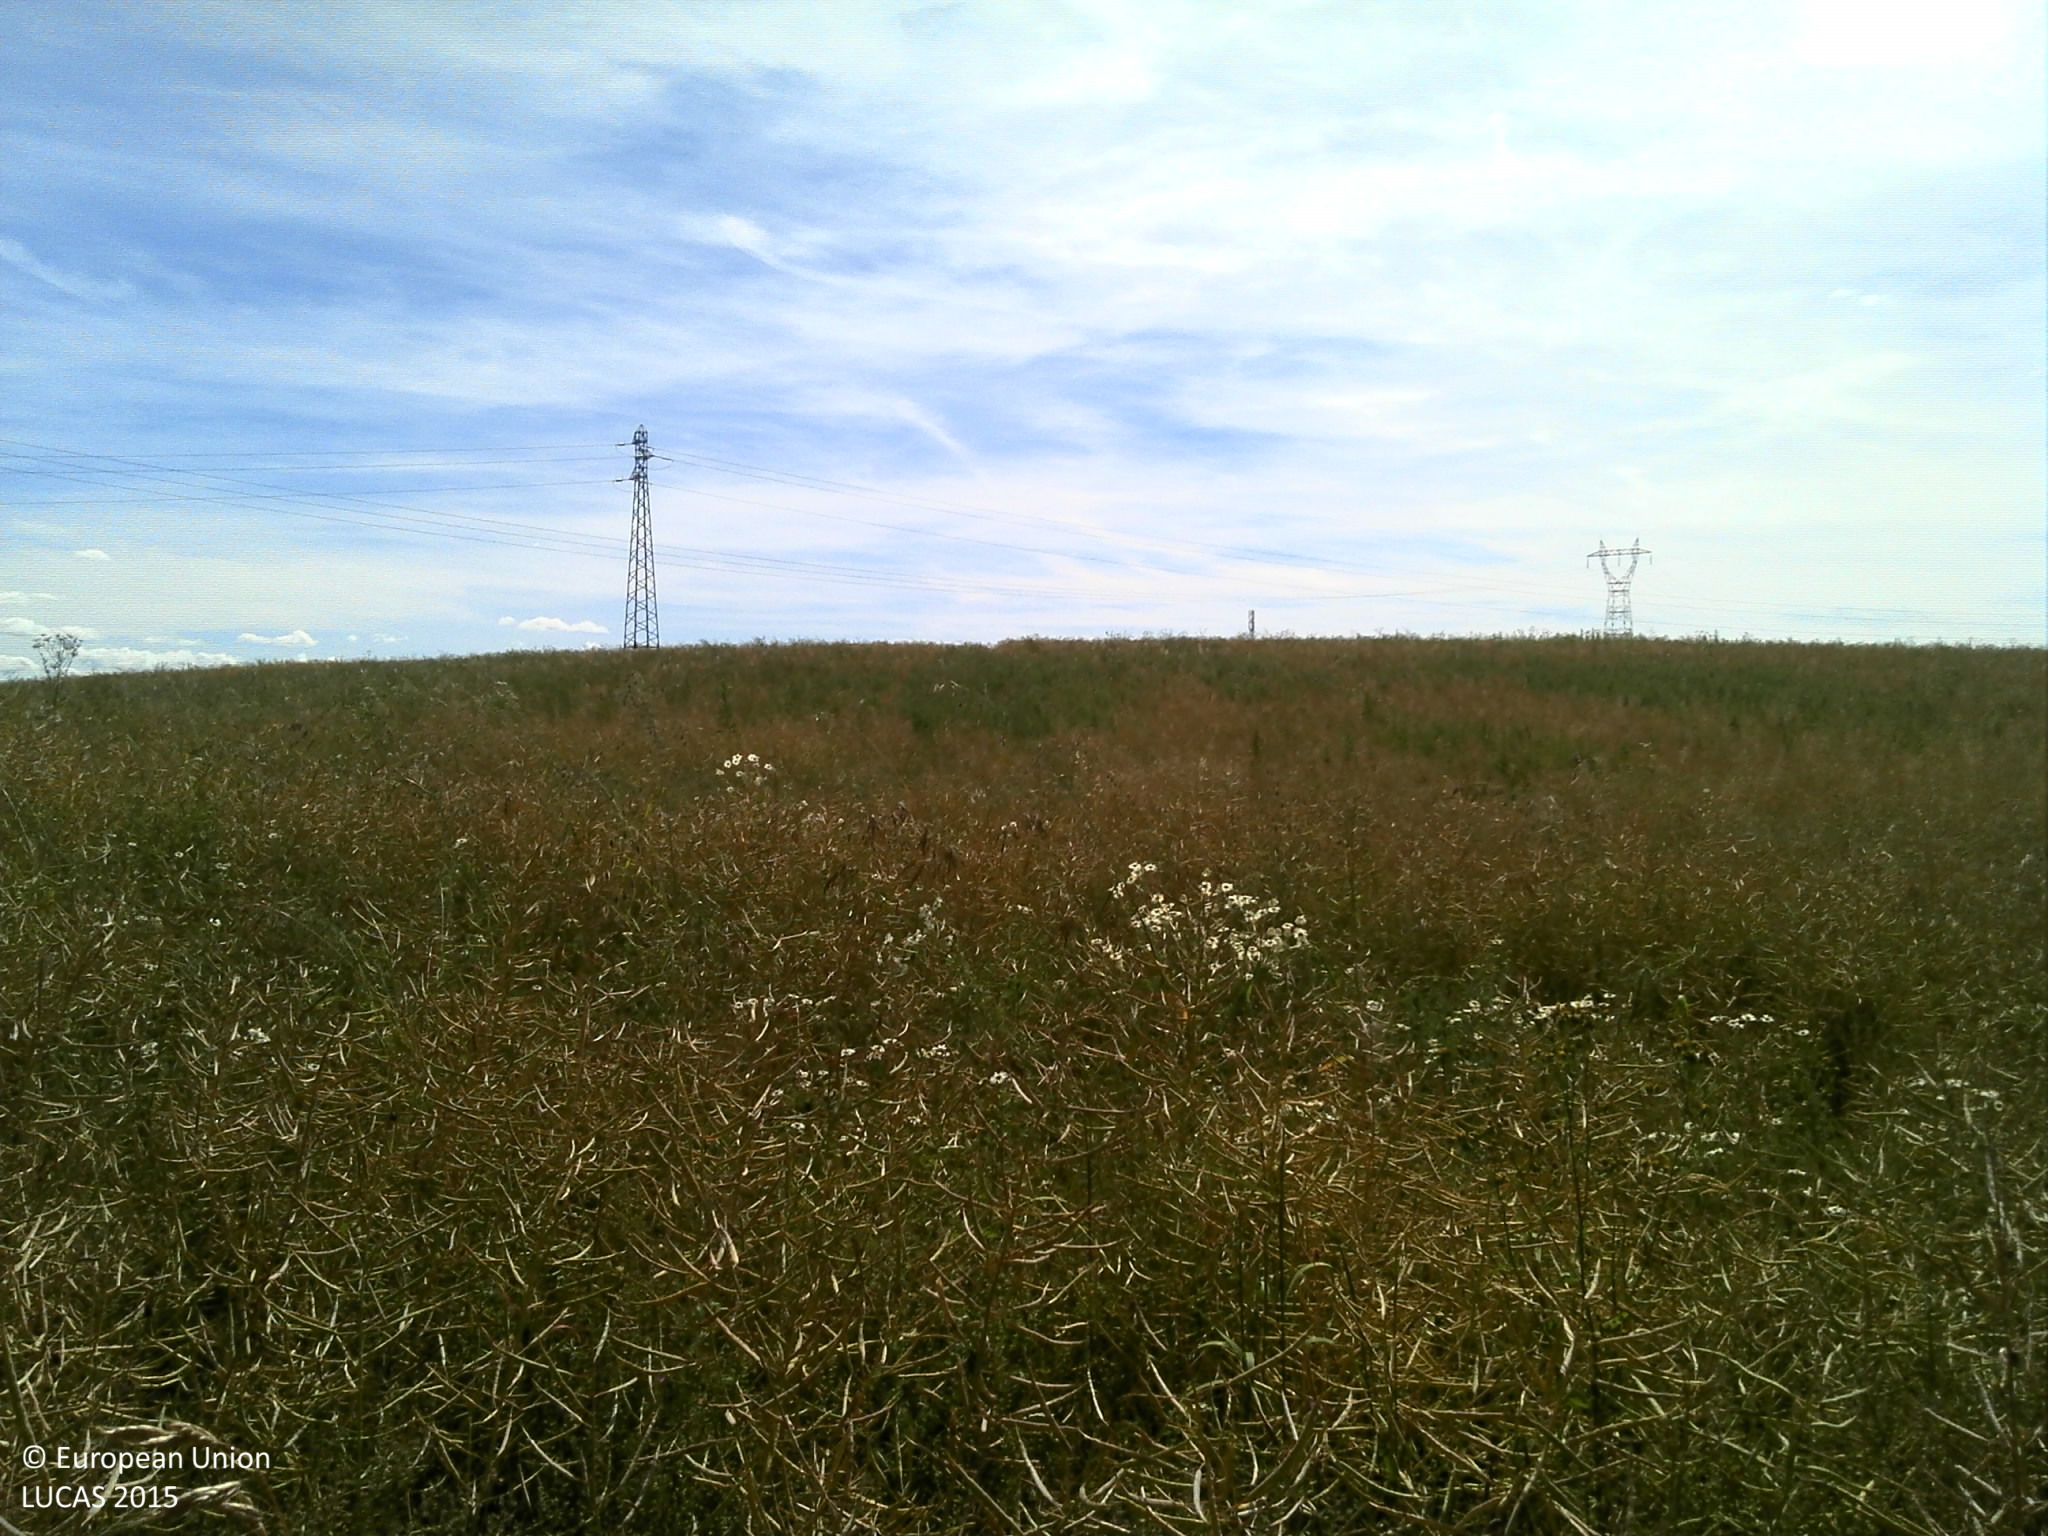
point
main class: Cropland
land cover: Rape and turnip rape
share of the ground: > 75 %
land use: Agriculture (excluding fallow land and kitchen gardens)
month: June
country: FR
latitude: 49.3227
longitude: 6.0233
